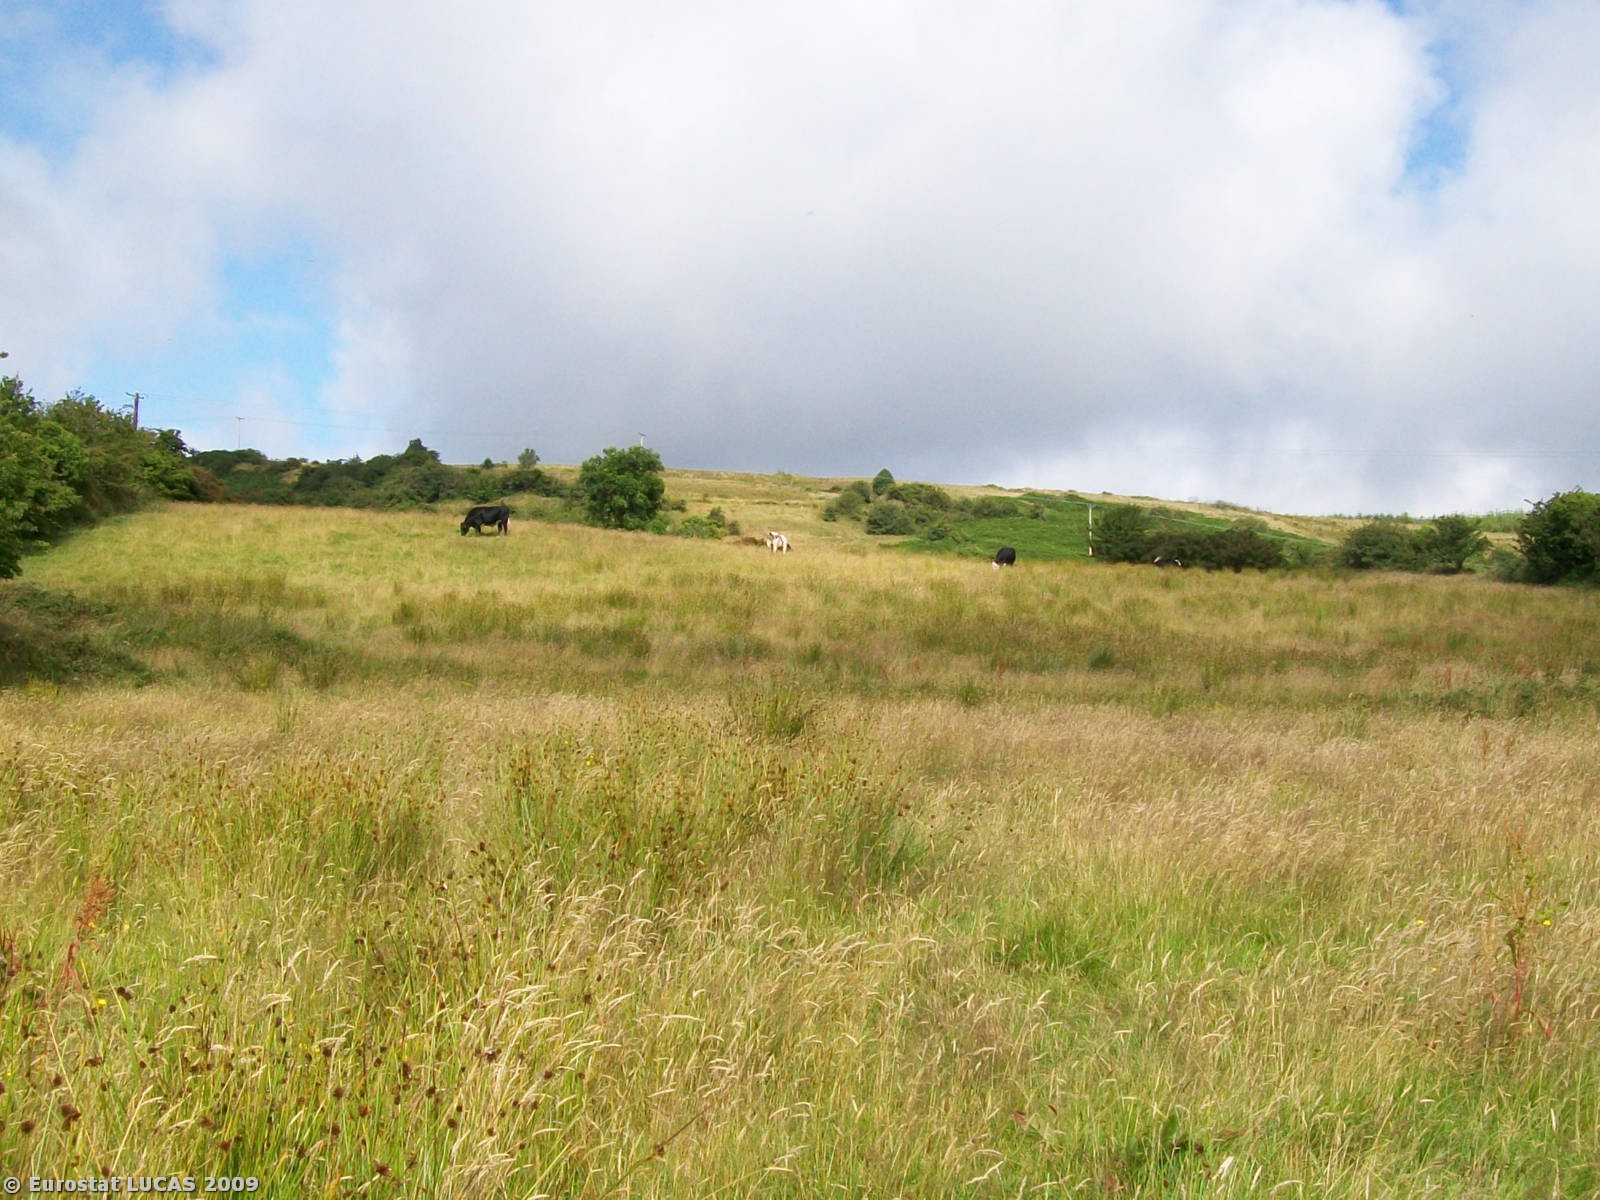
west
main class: Grassland
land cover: Grassland without tree/shrub cover
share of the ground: > 75 %
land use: Agriculture (excluding fallow land and kitchen gardens)
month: July
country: IE
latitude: 53.8498
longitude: -9.0477
